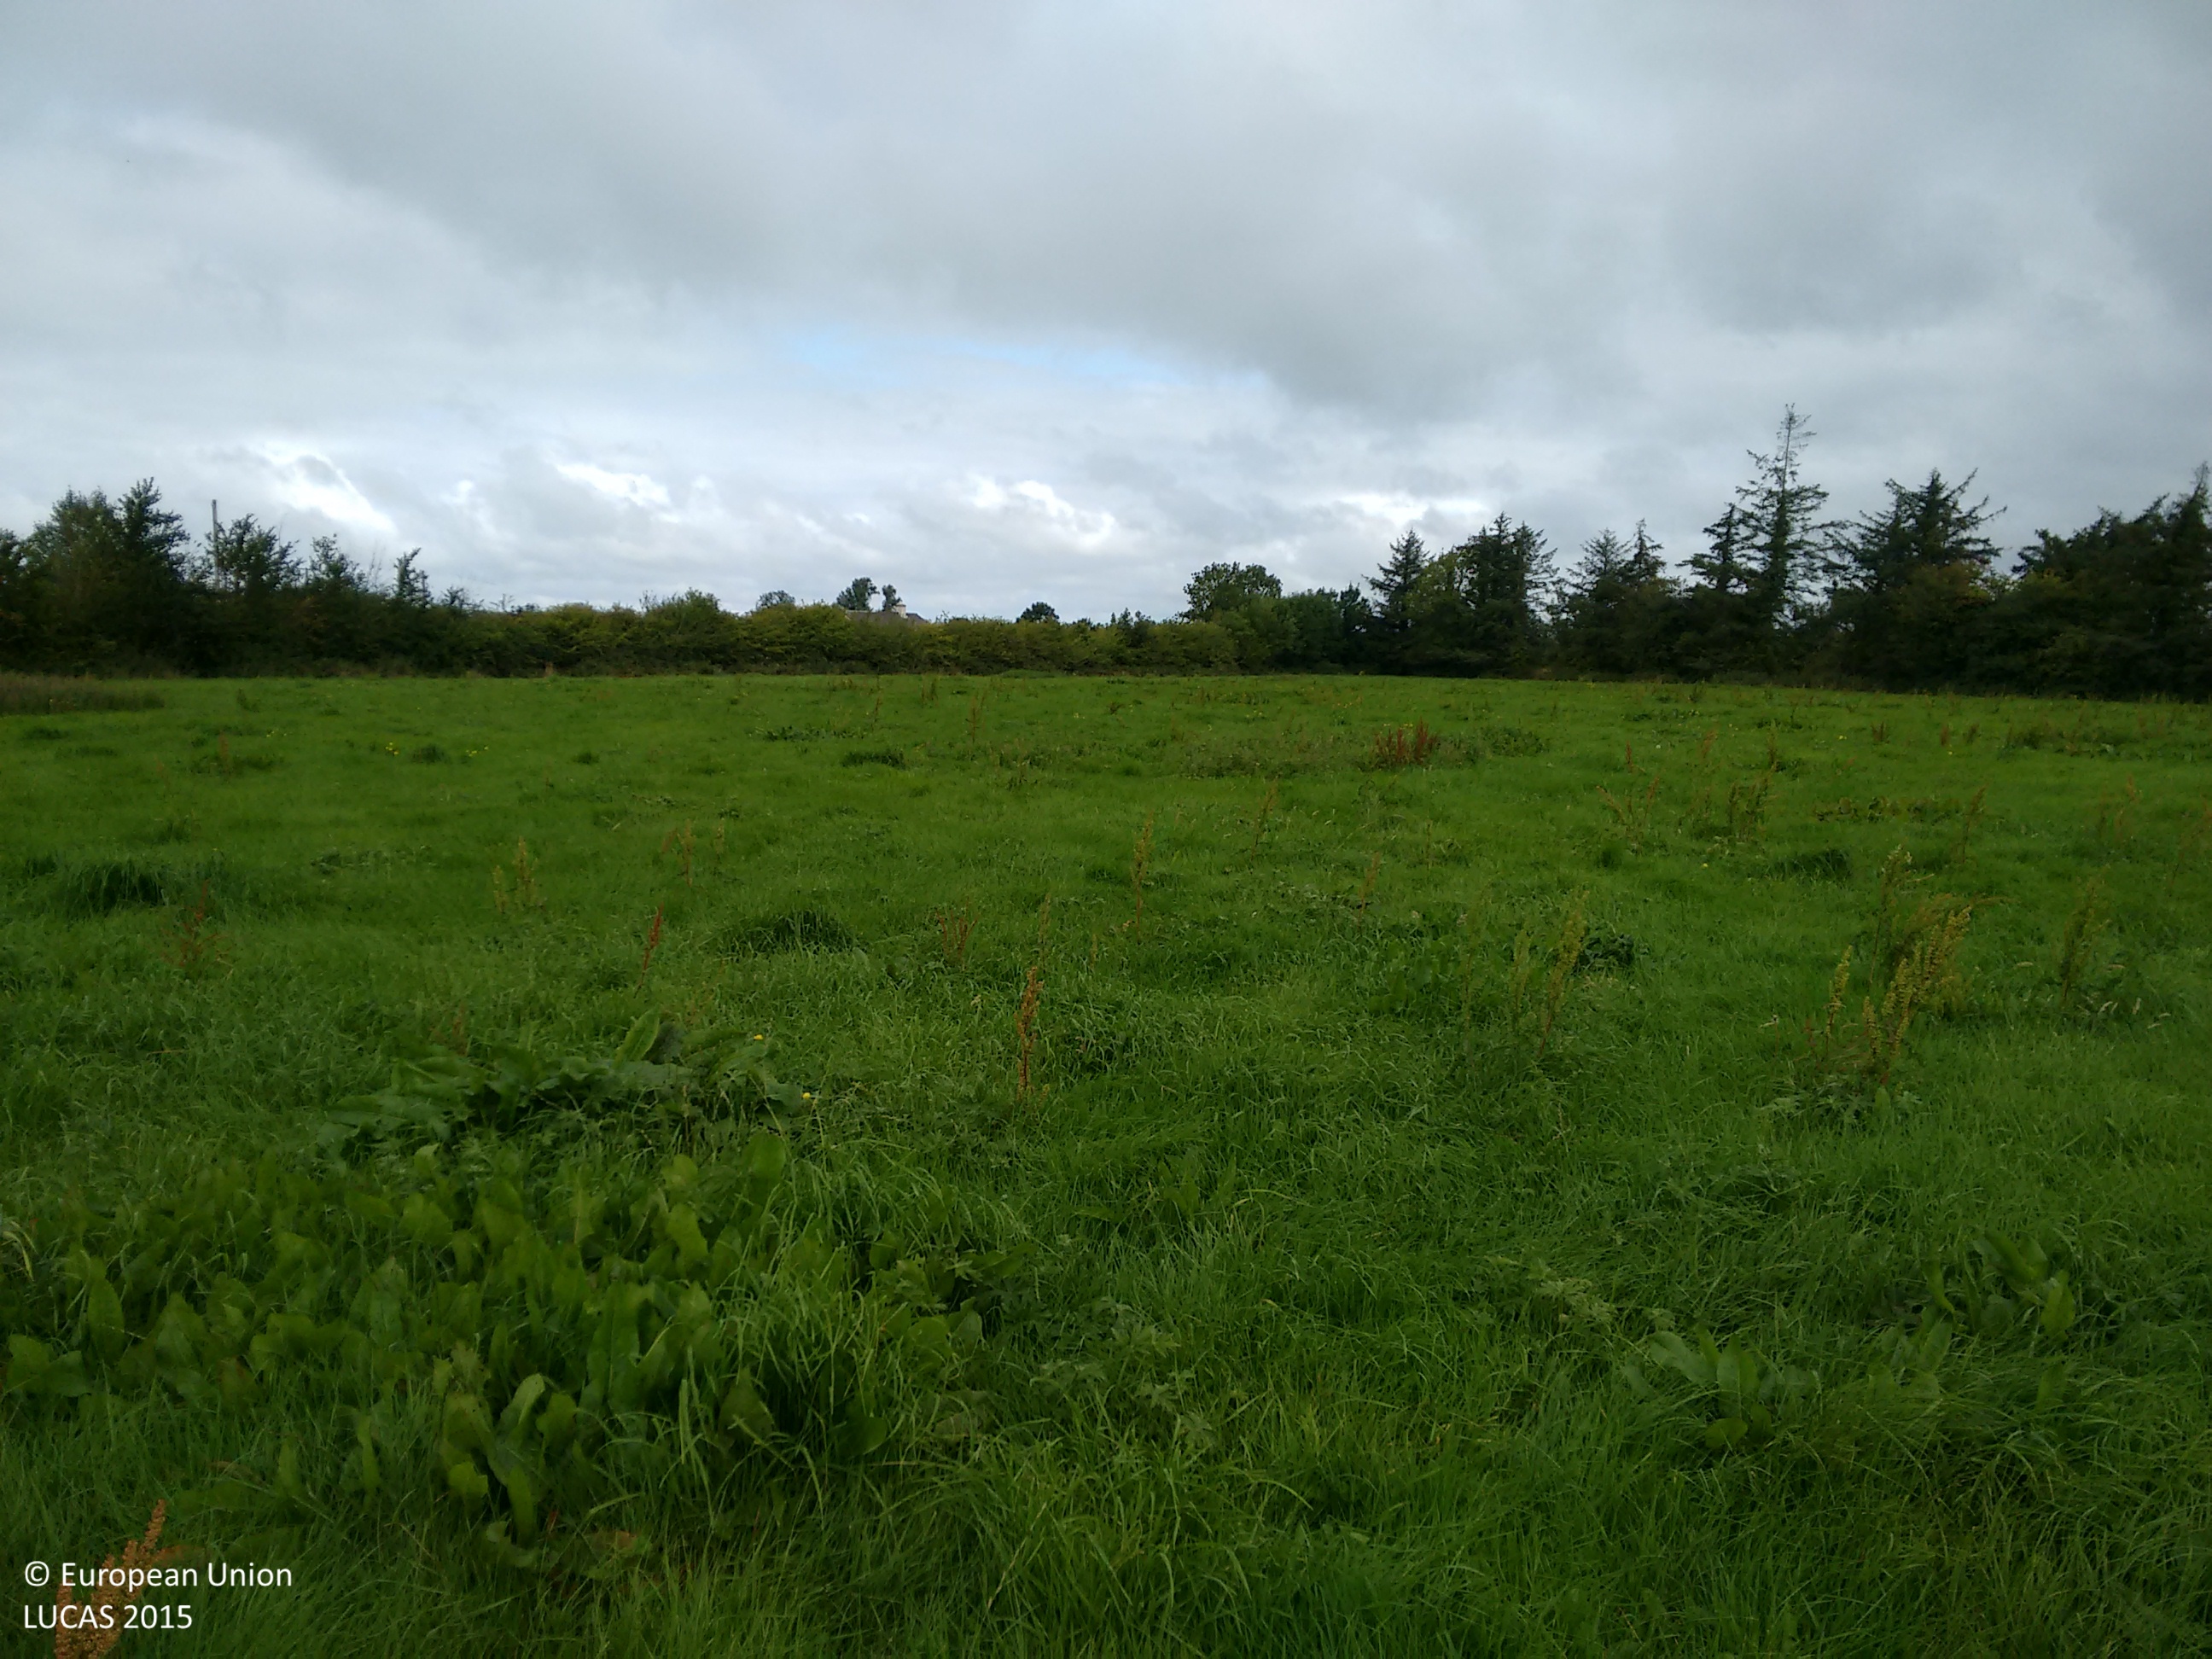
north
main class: Grassland
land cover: Grassland without tree/shrub cover
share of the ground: > 75 %
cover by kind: herbaceous plants 100 %
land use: Agriculture (excluding fallow land and kitchen gardens)
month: September
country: IE
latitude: 52.3847
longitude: -8.4854
